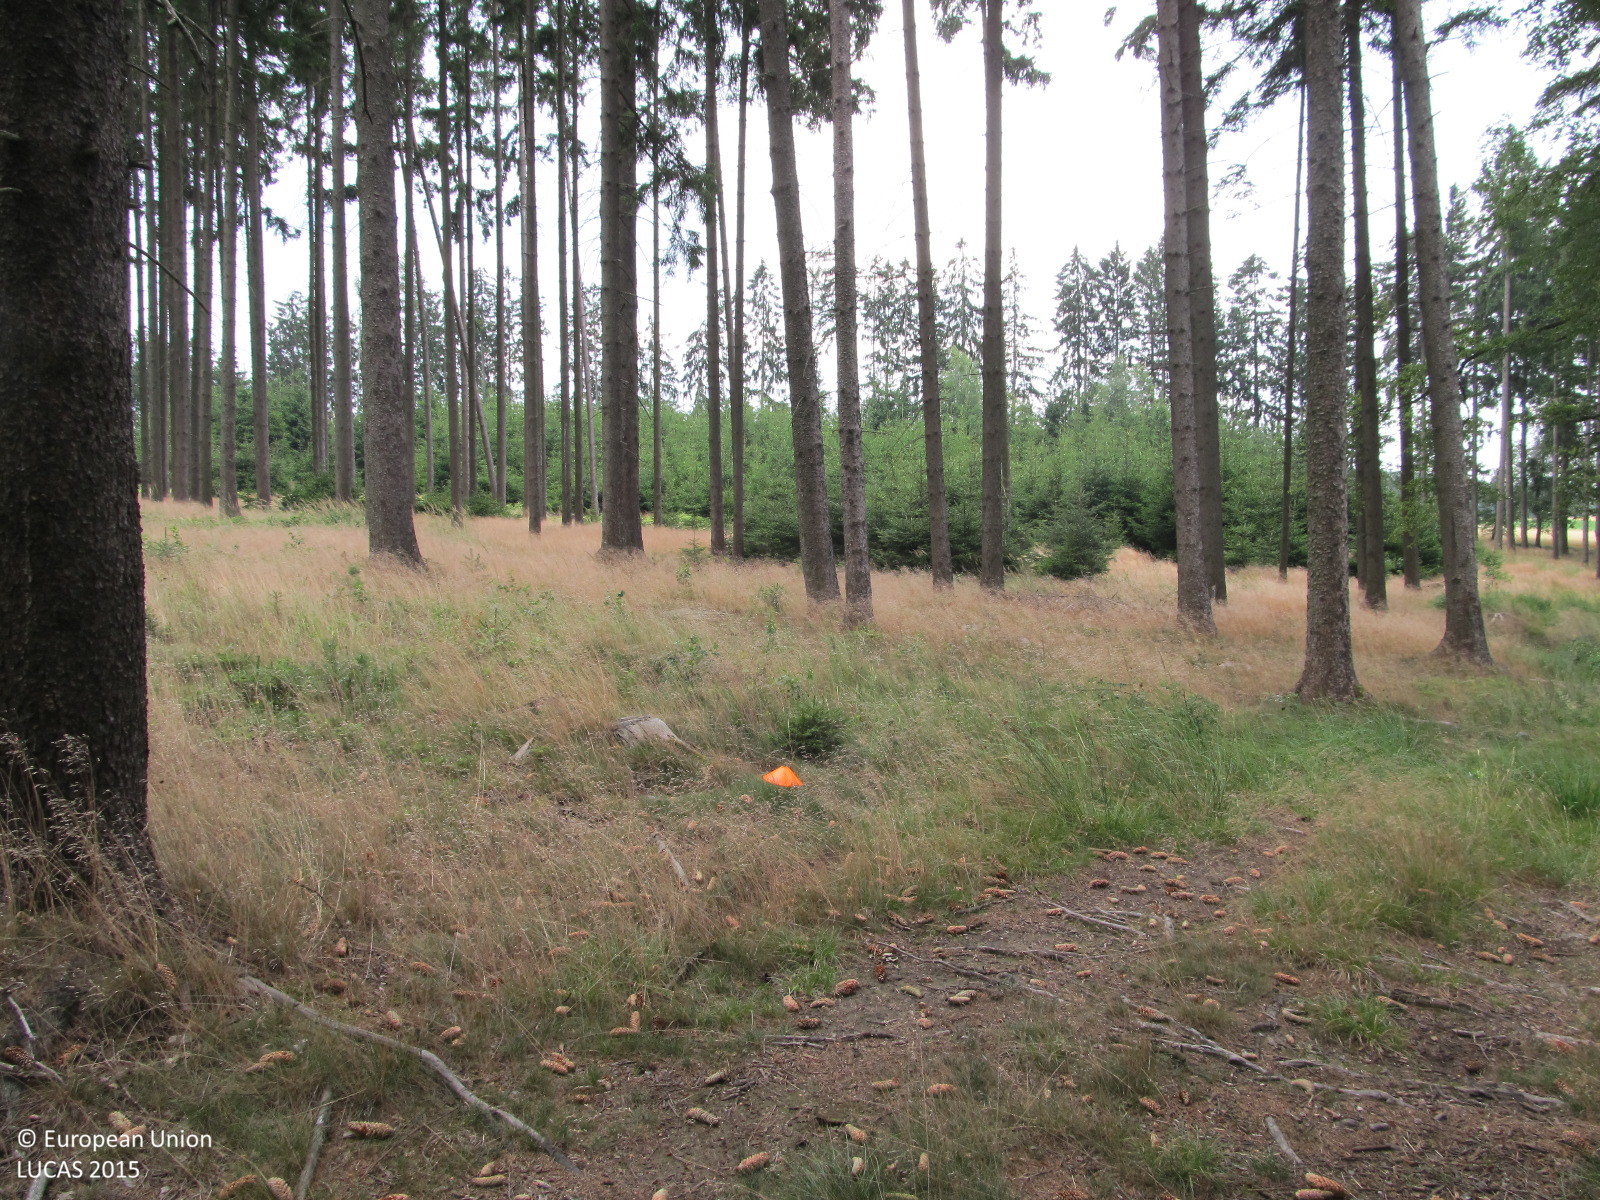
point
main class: Woodland
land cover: Spruce dominated coniferous woodland
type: hemiboreal forest and nemoral coniferous forest and mixed broadleaved-coniferous forest
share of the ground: > 75 %
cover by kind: coniferous forest trees 75 %, herbaceous plants 15 %, shrubs 10 %
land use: Forestry
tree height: > 5 m
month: July
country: AT
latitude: 48.2853
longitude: 15.4875
